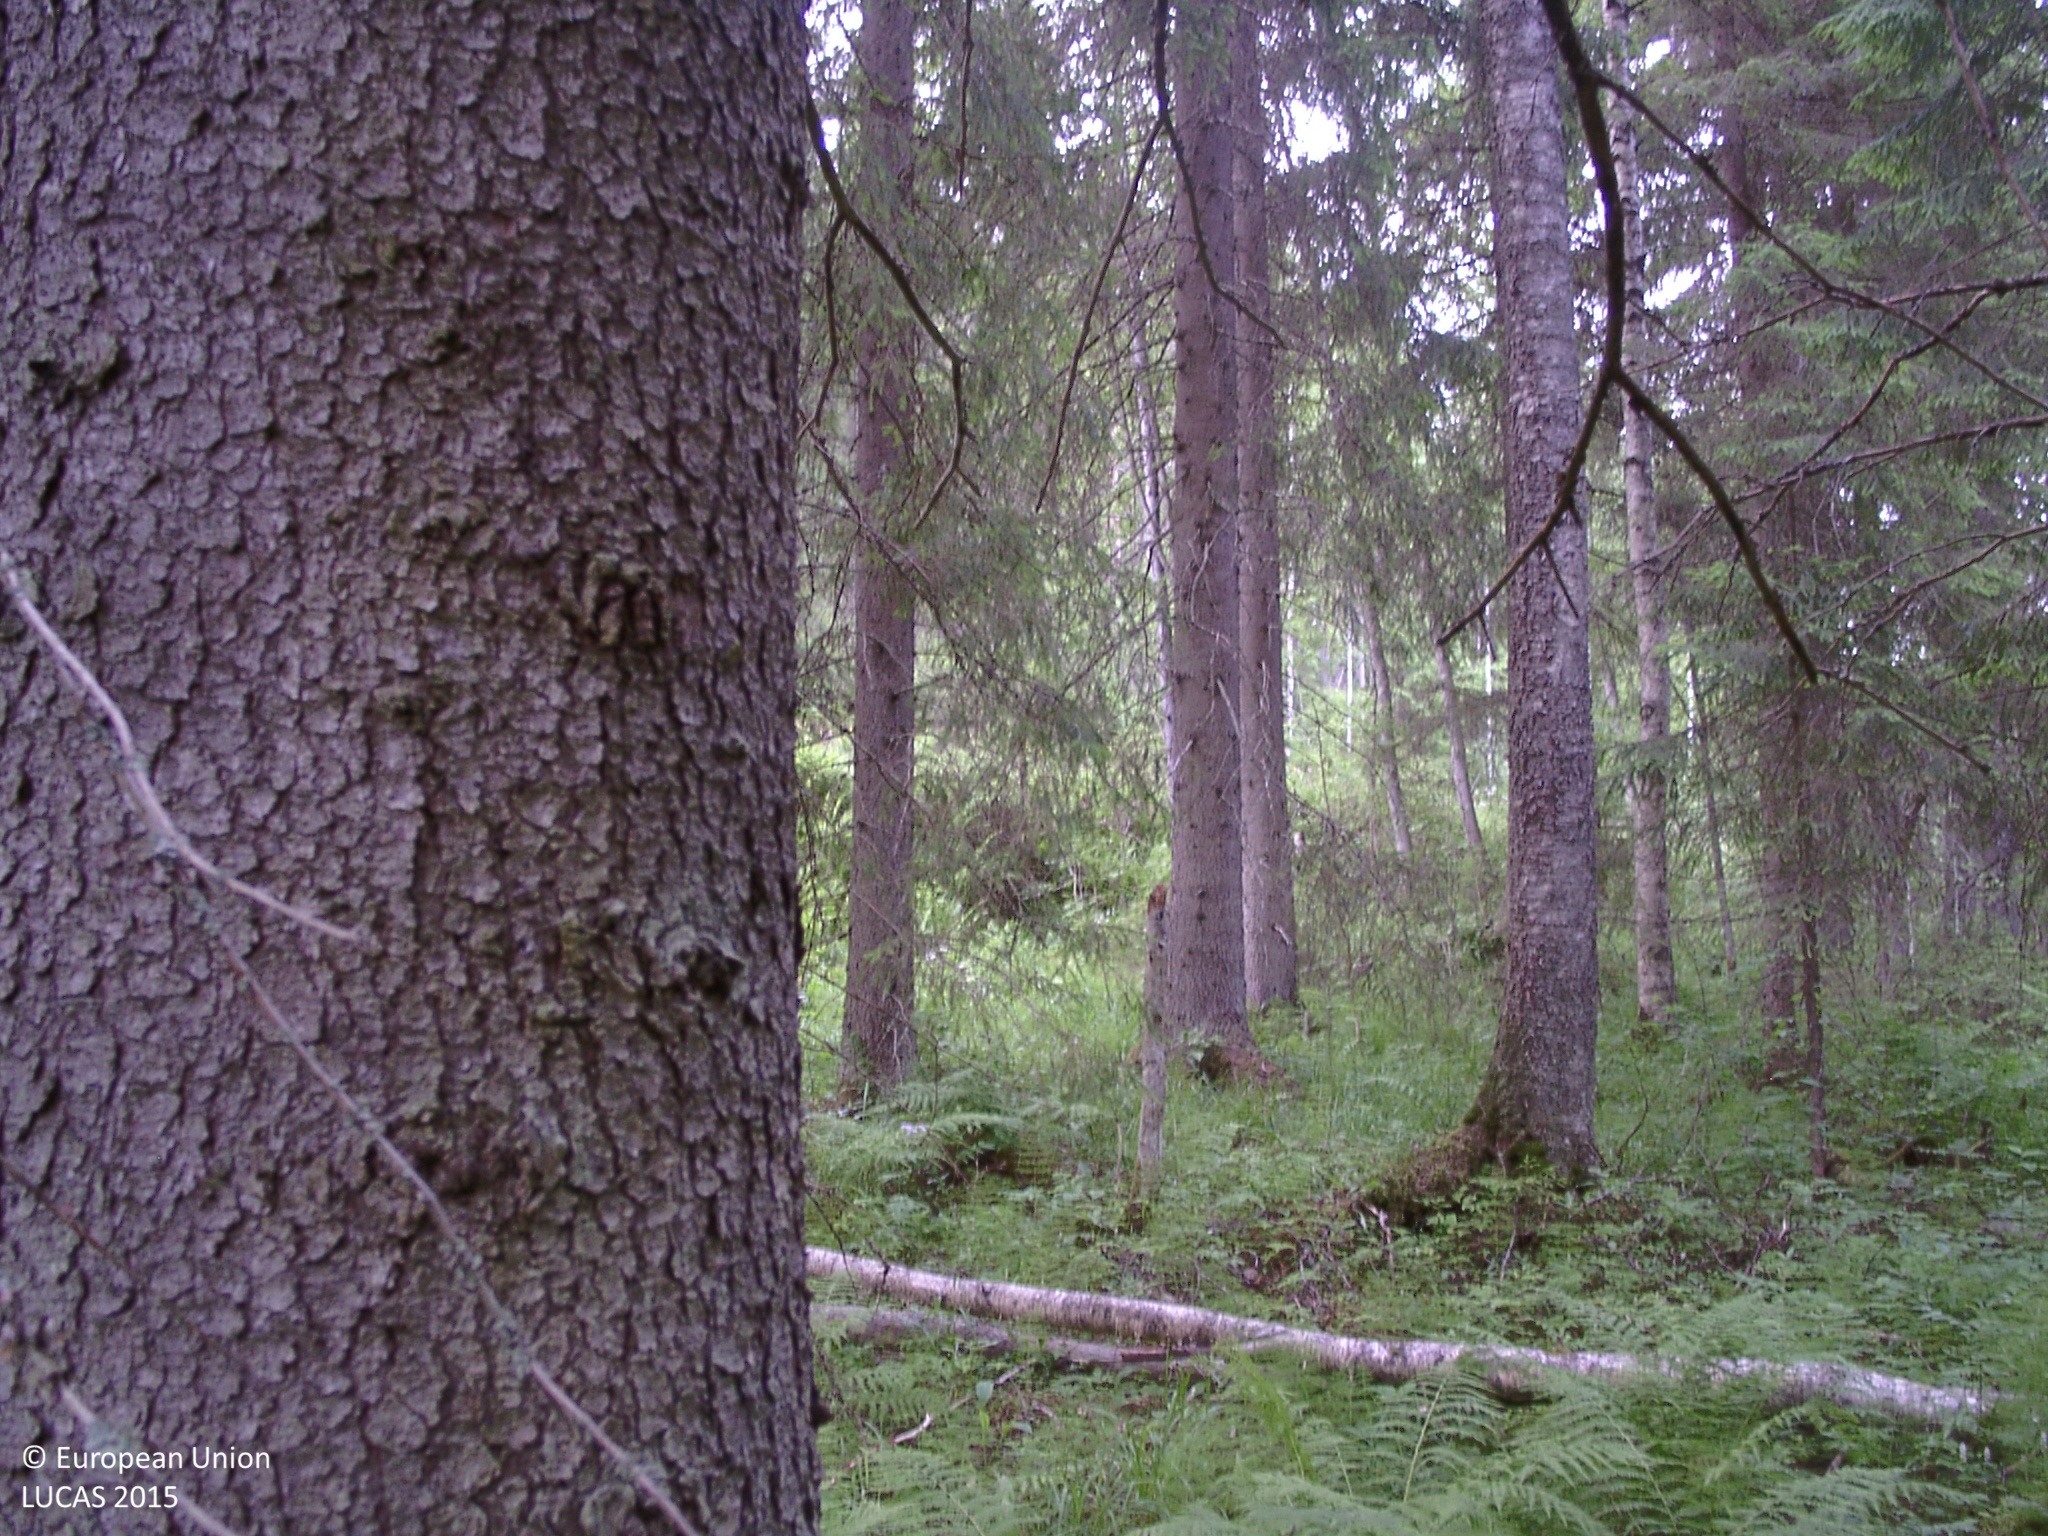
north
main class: Woodland
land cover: Spruce dominated mixed woodland
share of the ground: 50 - 75 %
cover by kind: coniferous forest trees 45 %, herbaceous plants 30 %, broadleaved forest trees 20 %, lichens and mosses 5 %
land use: Forestry
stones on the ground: < 10 %
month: July
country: FI
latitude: 62.0102
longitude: 25.4528
